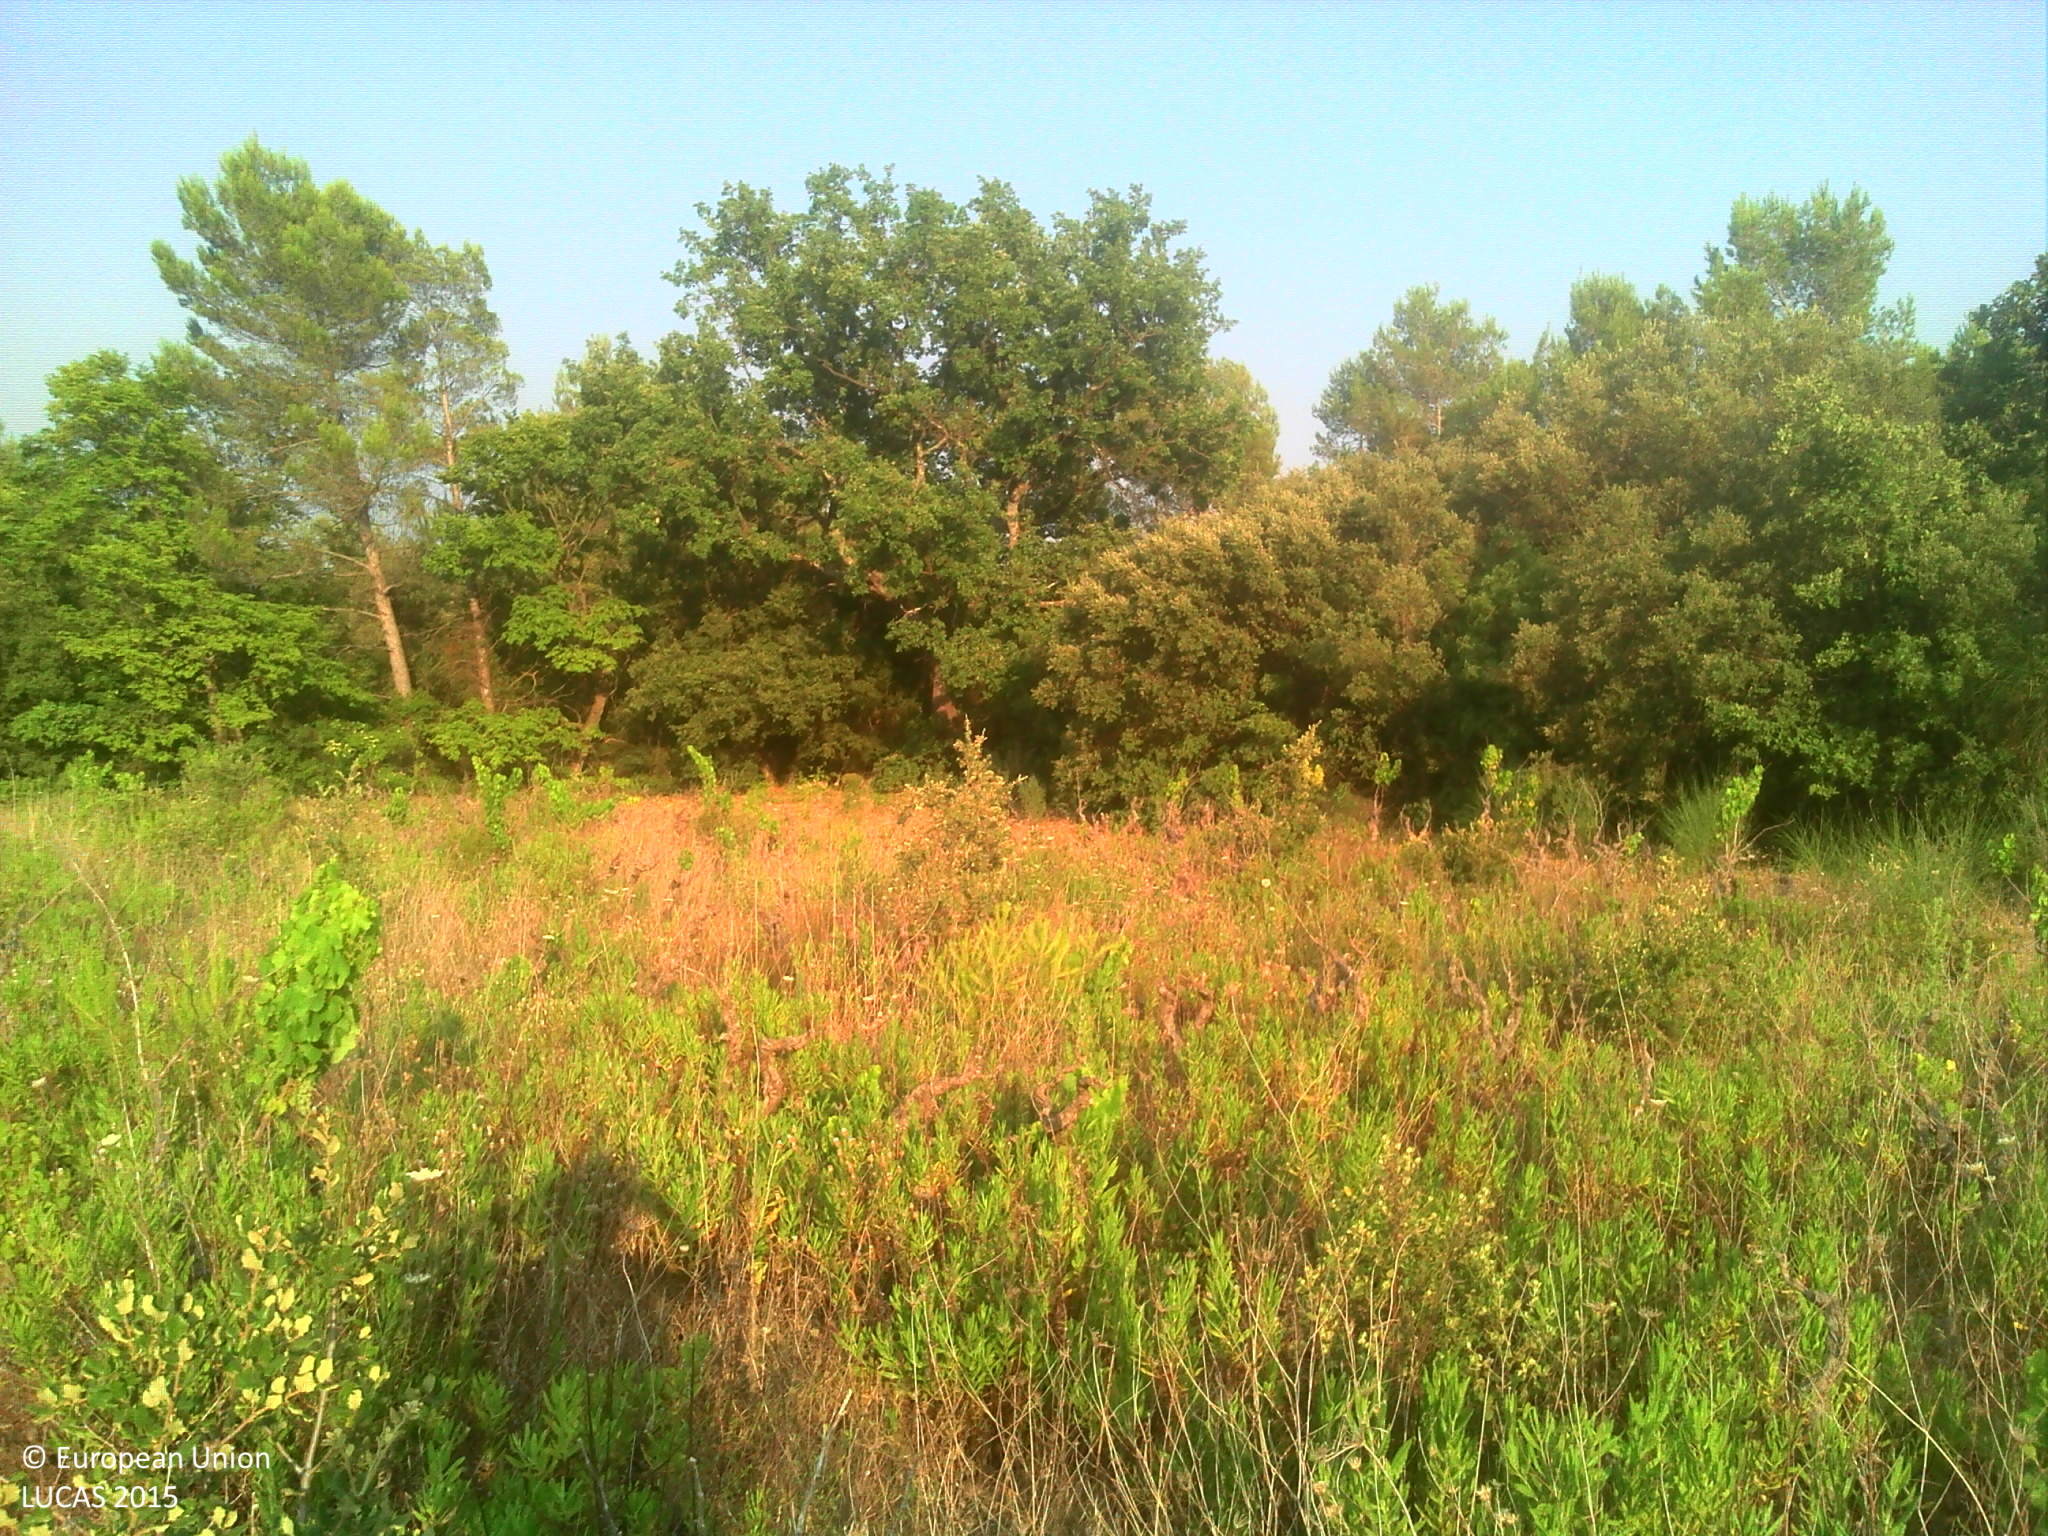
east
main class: Cropland
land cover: Vineyards
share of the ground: 25 - 50 %
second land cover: Grassland without tree/shrub cover
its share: > 75 %
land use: Abandoned areas
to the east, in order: Vineyards; Grassland without tree/shrub cover; Tracks; Rock outcrops; Pine dominated mixed woodland; Dry stone walls; Pine dominated mixed woodland; Shrubland with sparse tree cover; Tracks; Pine dominated mixed woodland
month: July
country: FR
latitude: 43.4192
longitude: 6.3407
